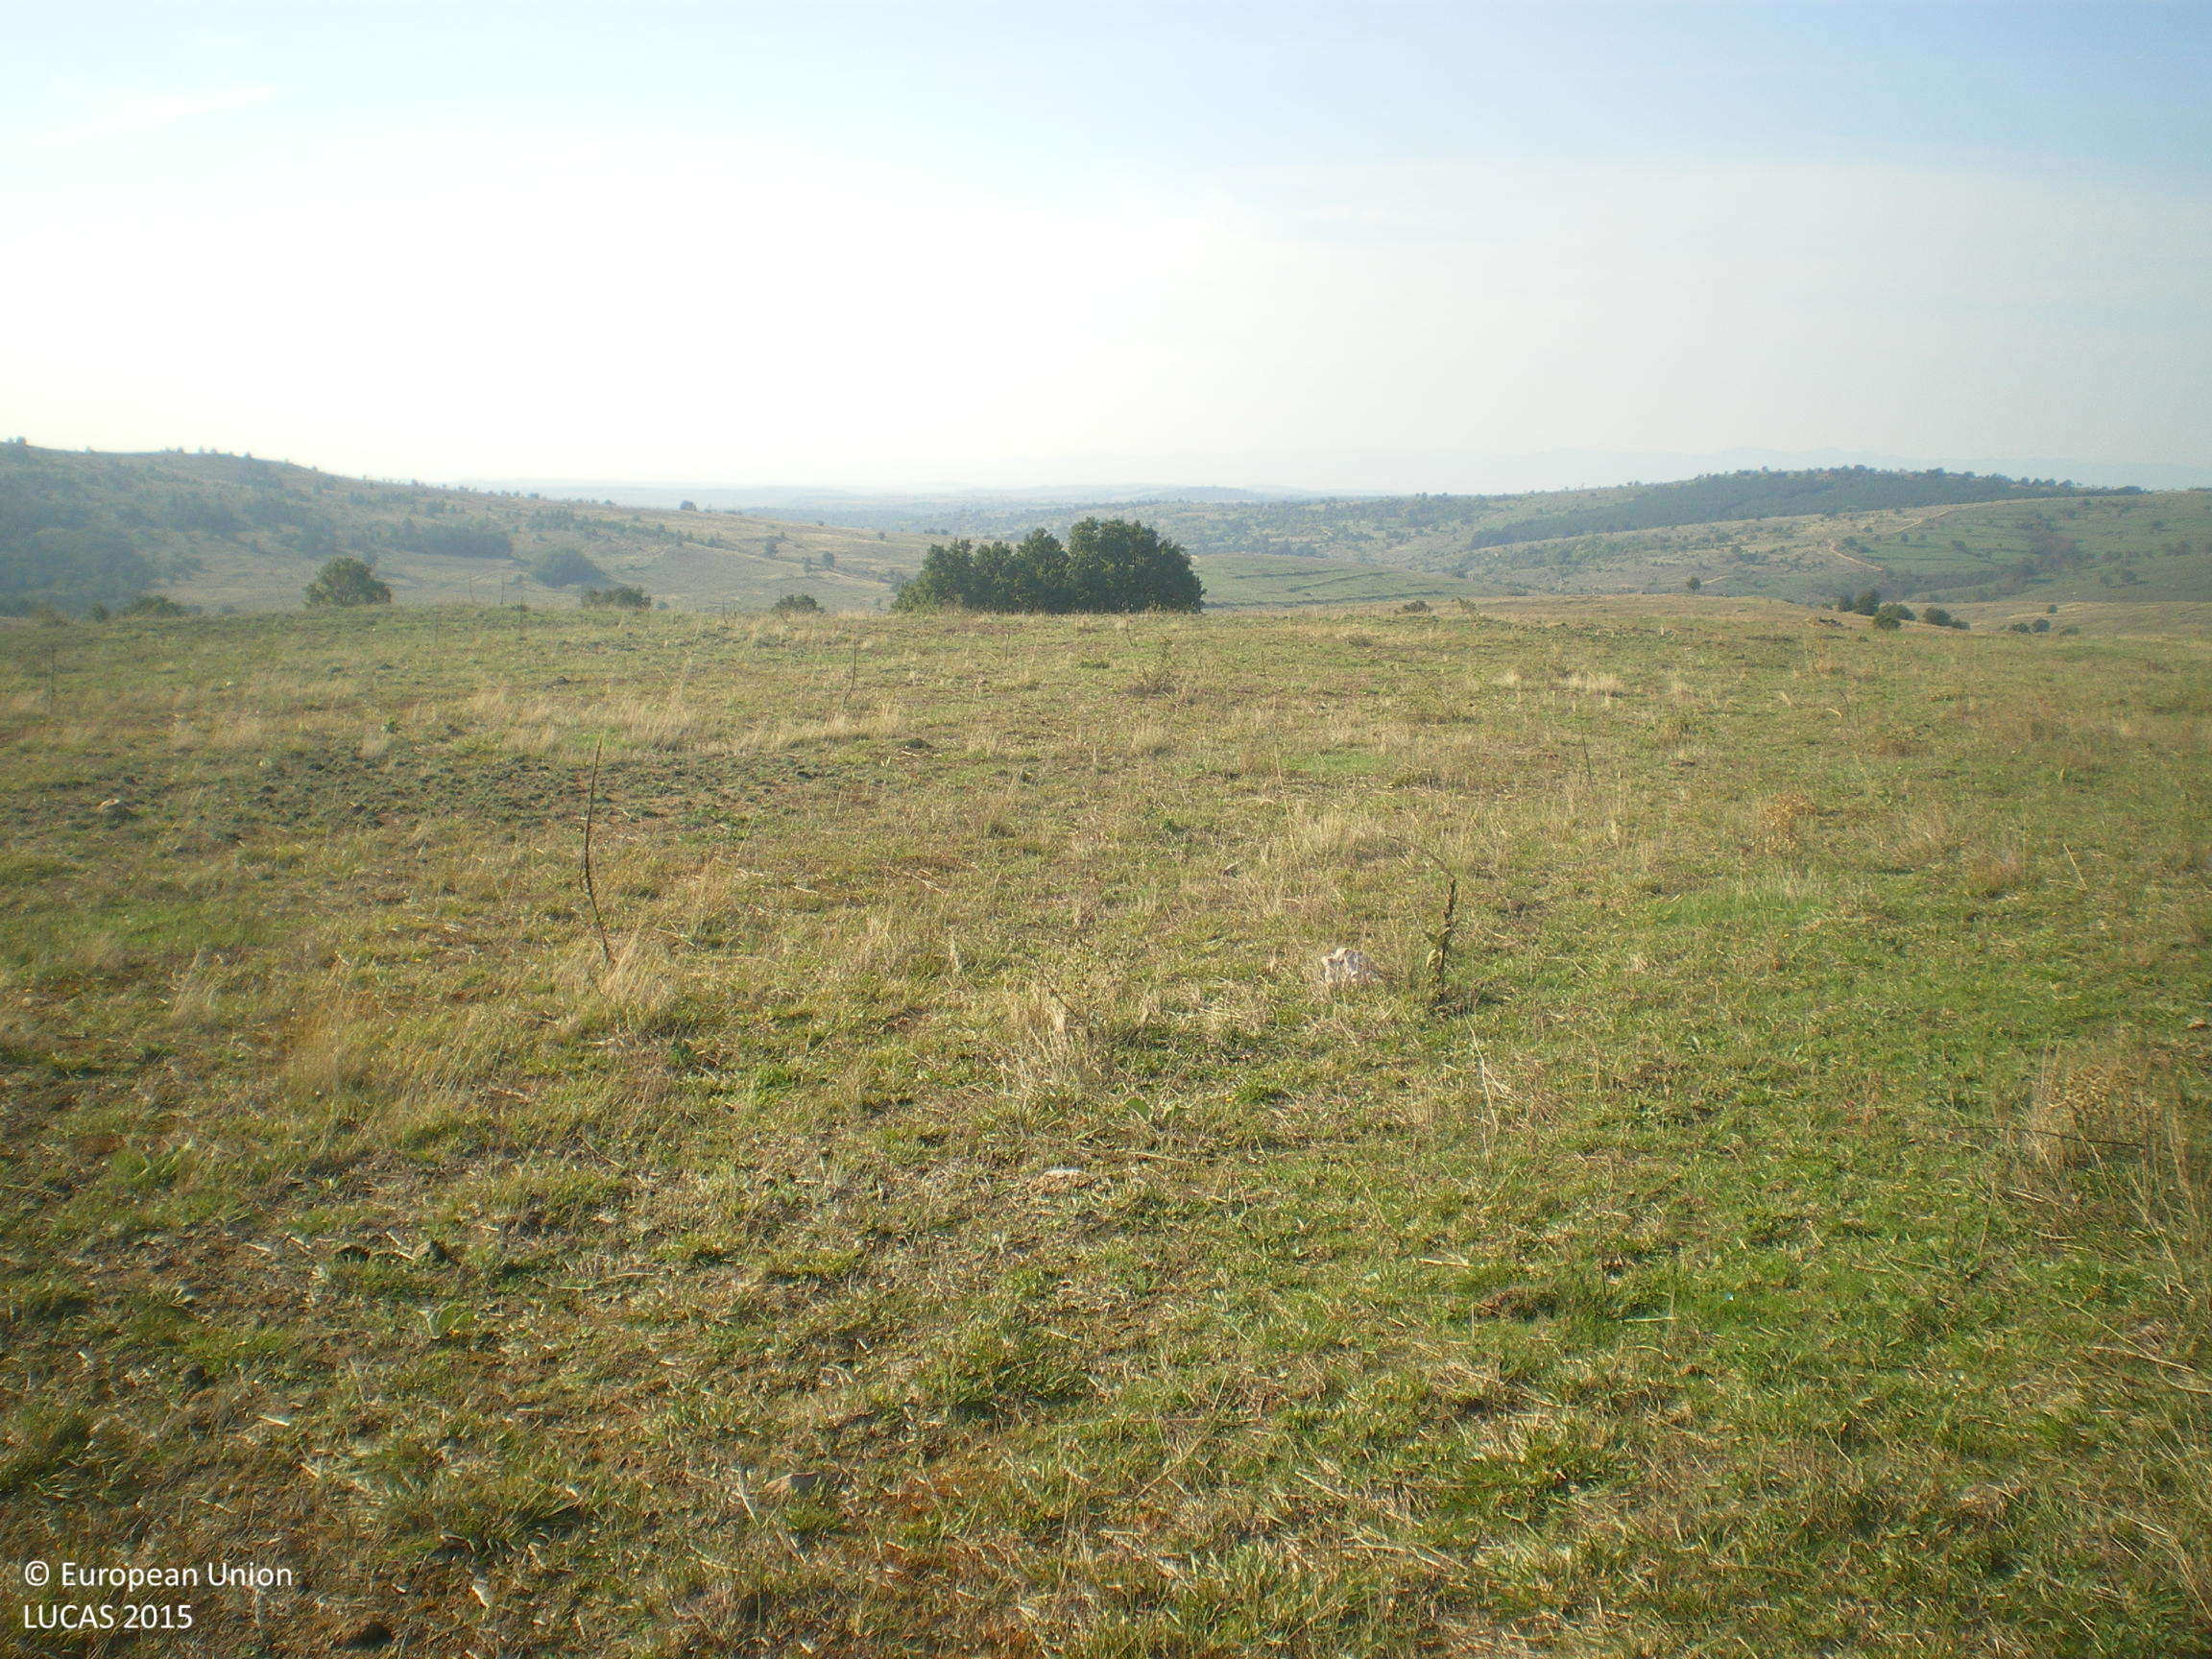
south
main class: Grassland
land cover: Grassland without tree/shrub cover
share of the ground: > 75 %
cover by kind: herbaceous plants 100 %
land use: Agriculture (excluding fallow land and kitchen gardens)
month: October
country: BG
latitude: 41.9982
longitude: 26.2202
